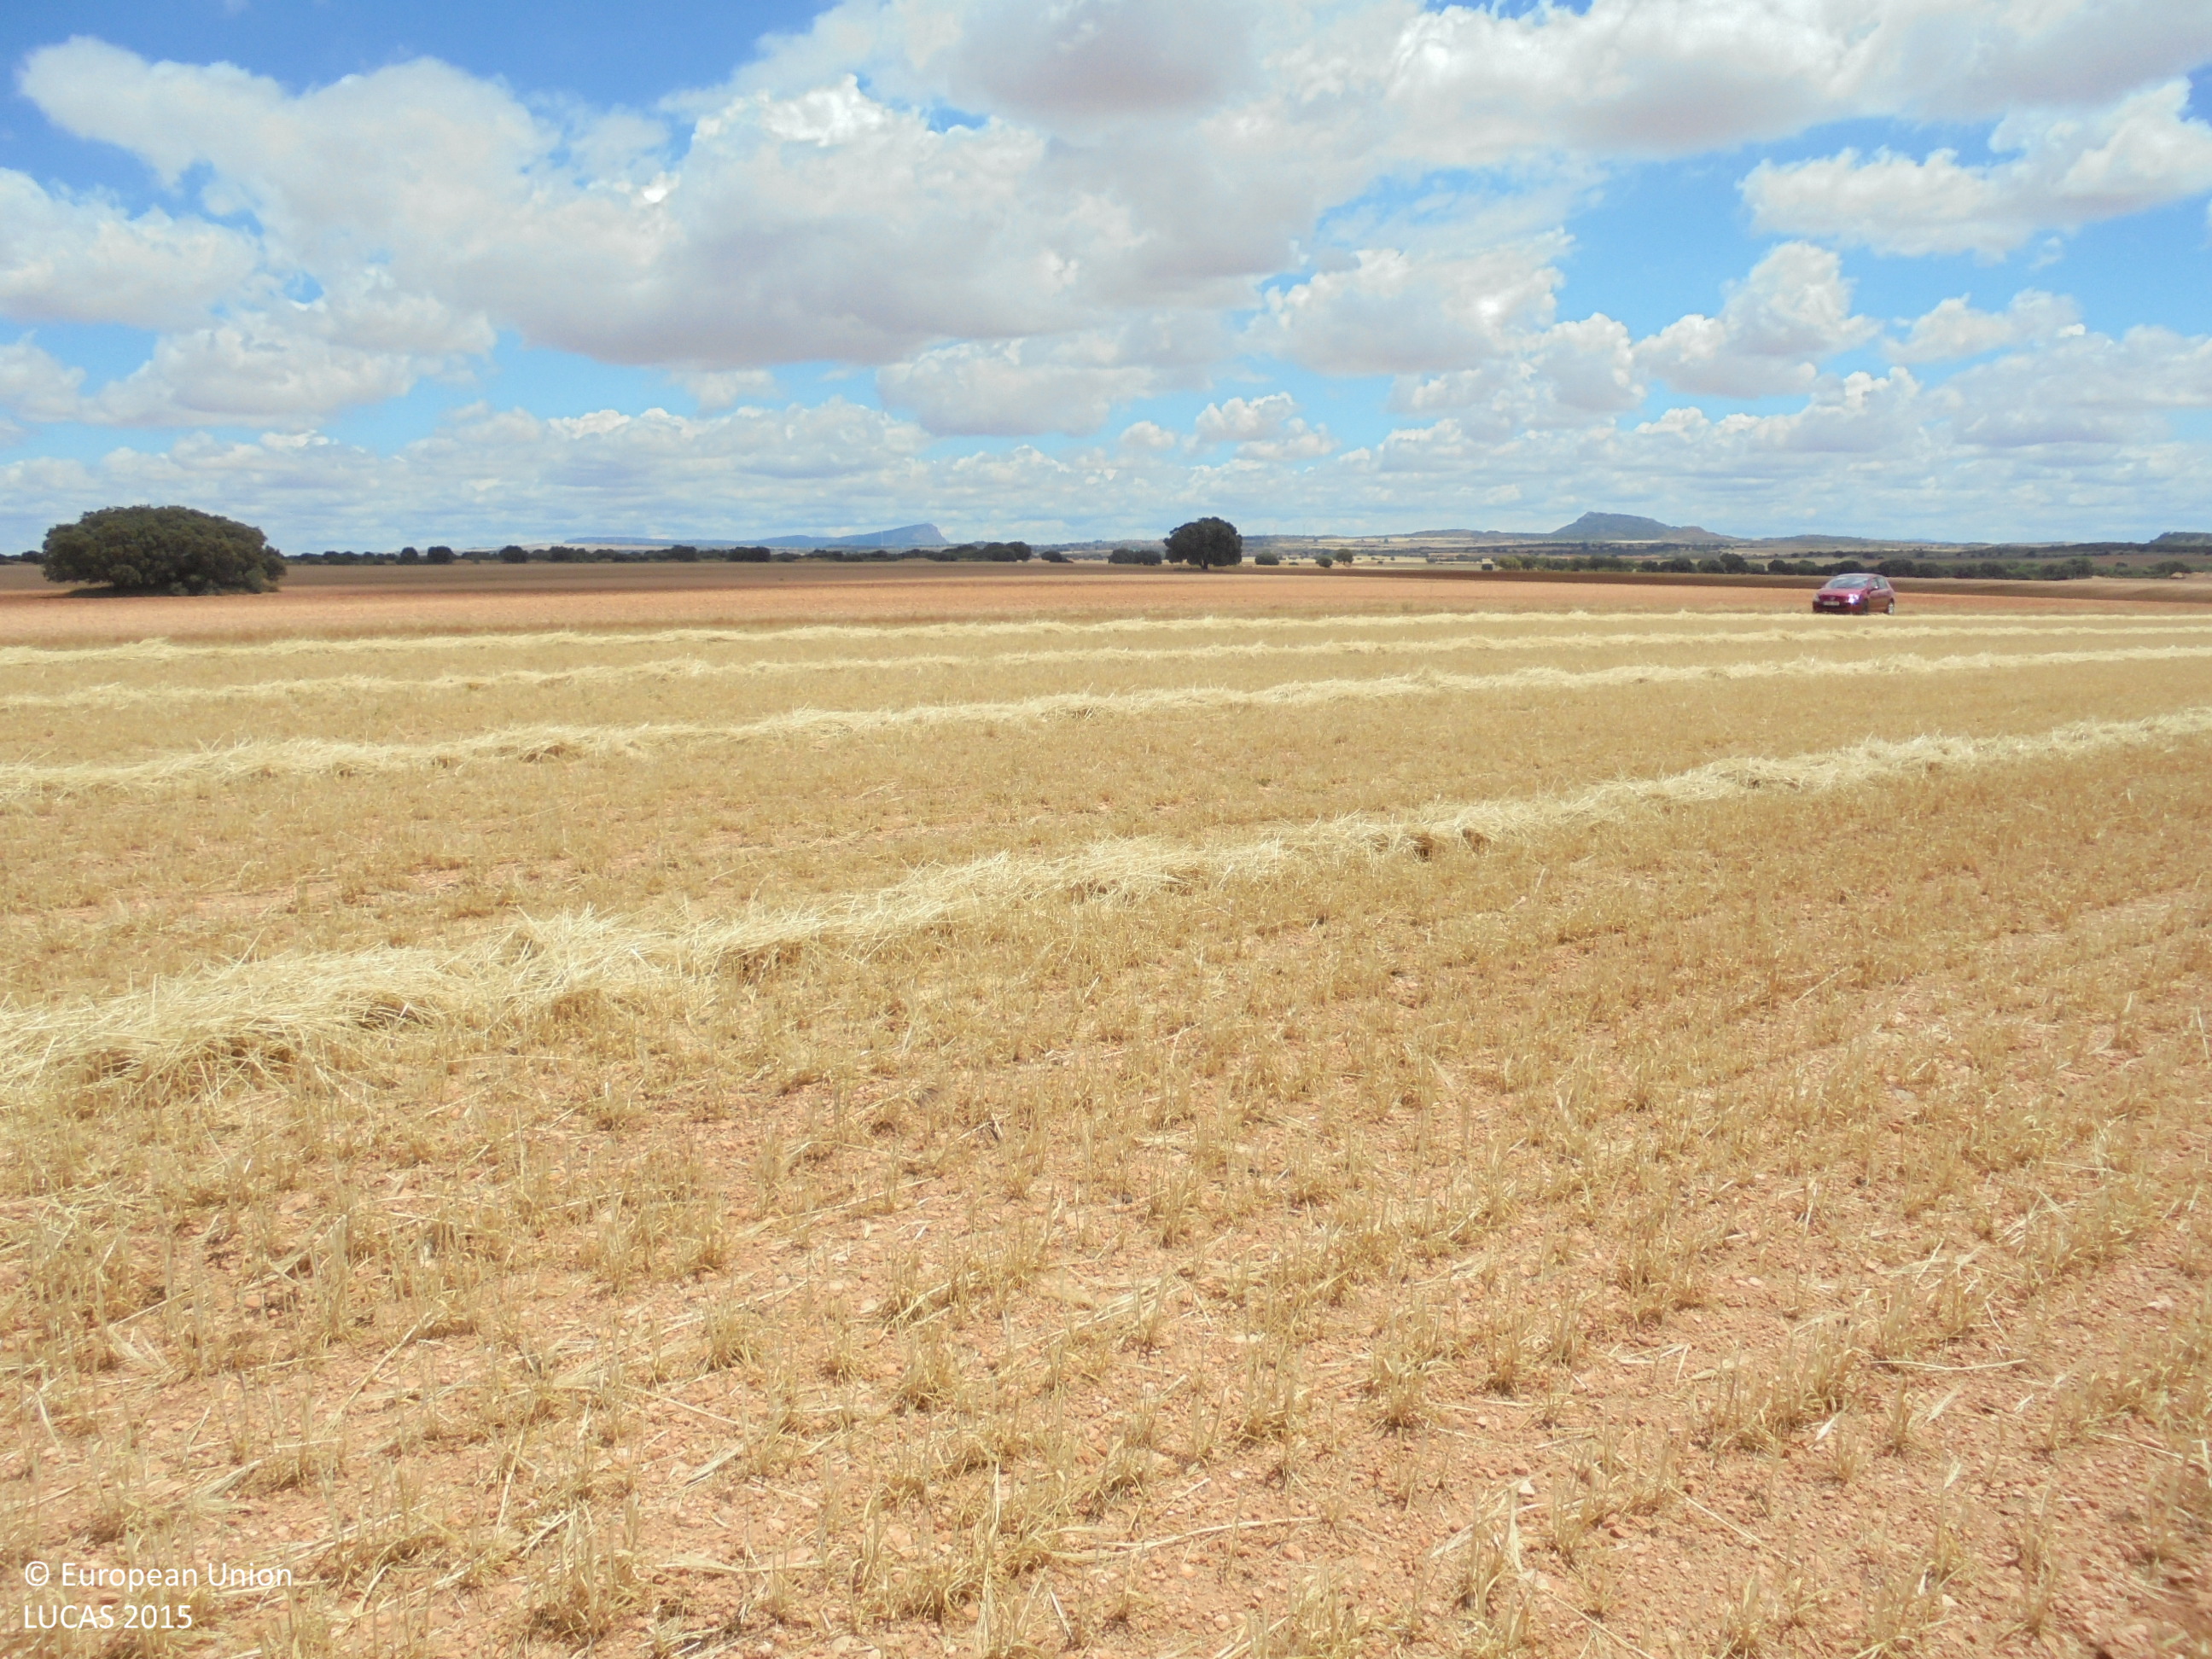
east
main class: Cropland
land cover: Barley
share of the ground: 50 - 75 %
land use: Agriculture (excluding fallow land and kitchen gardens)
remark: Harvested field
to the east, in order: Barley; Grass margins; Tracks; Grass margins; Other bare soil
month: June
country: ES
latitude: 38.8652
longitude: -1.4403
